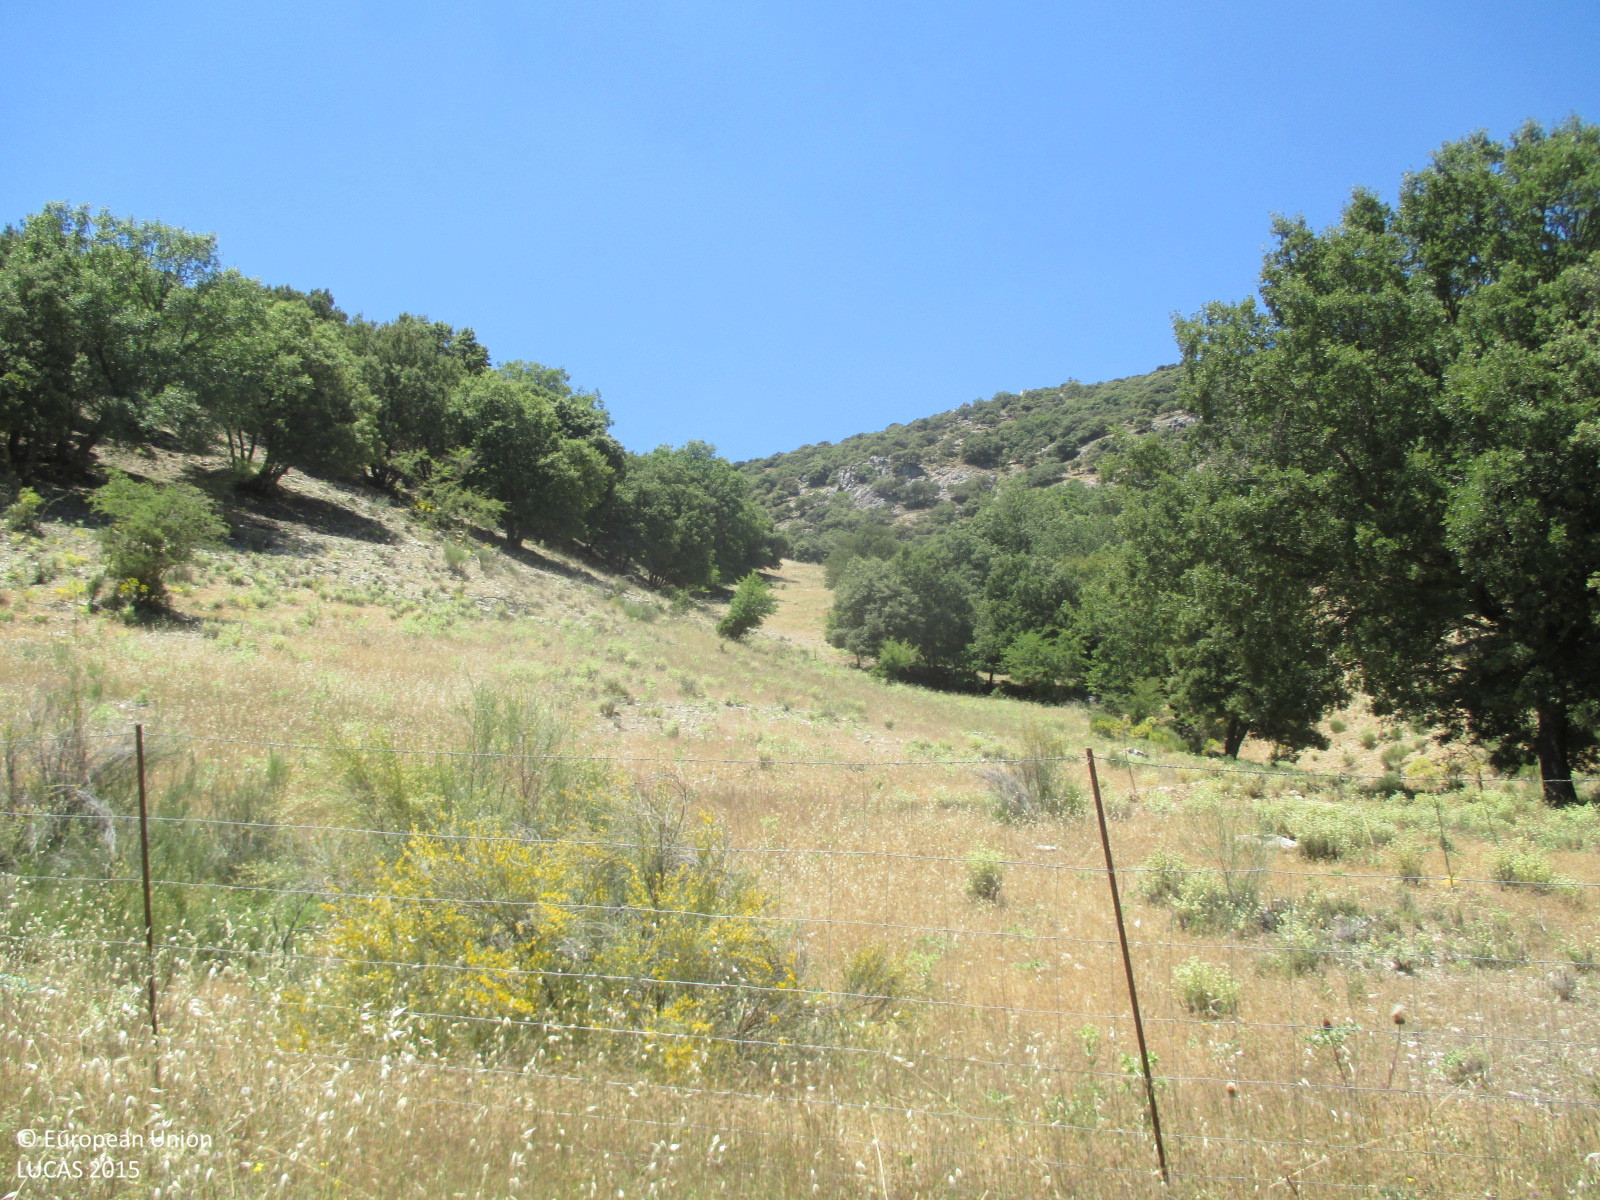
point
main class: Woodland
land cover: Broadleaved woodland
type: broadleaved evergreen forest
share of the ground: 50 - 75 %
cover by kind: broadleaved forest trees 50 %, herbaceous plants 50 %
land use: Semi-natural and natural areas not in use
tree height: > 5 m
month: June
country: ES
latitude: 37.5095
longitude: -3.7869
